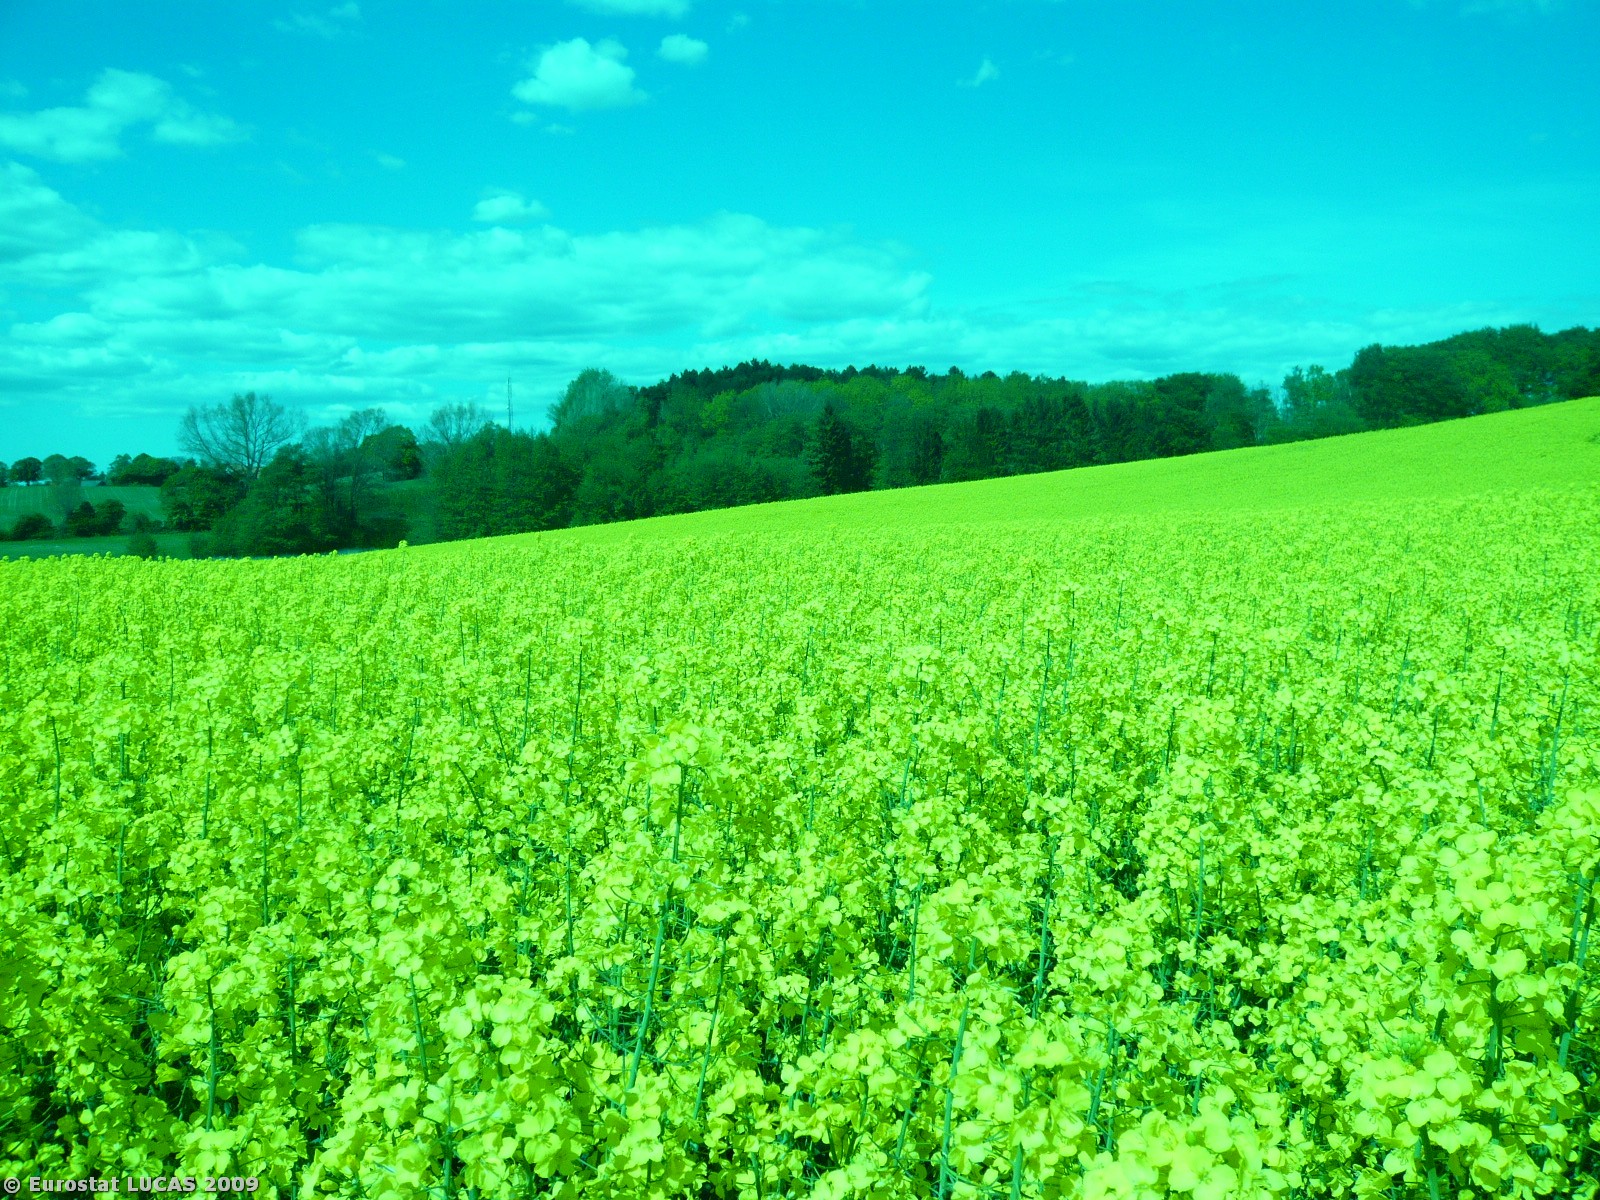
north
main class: Cropland
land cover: Rape and turnip rape
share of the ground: > 75 %
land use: Agriculture (excluding fallow land and kitchen gardens)
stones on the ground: < 10 %
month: May
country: DK
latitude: 55.0037
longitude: 11.9842
